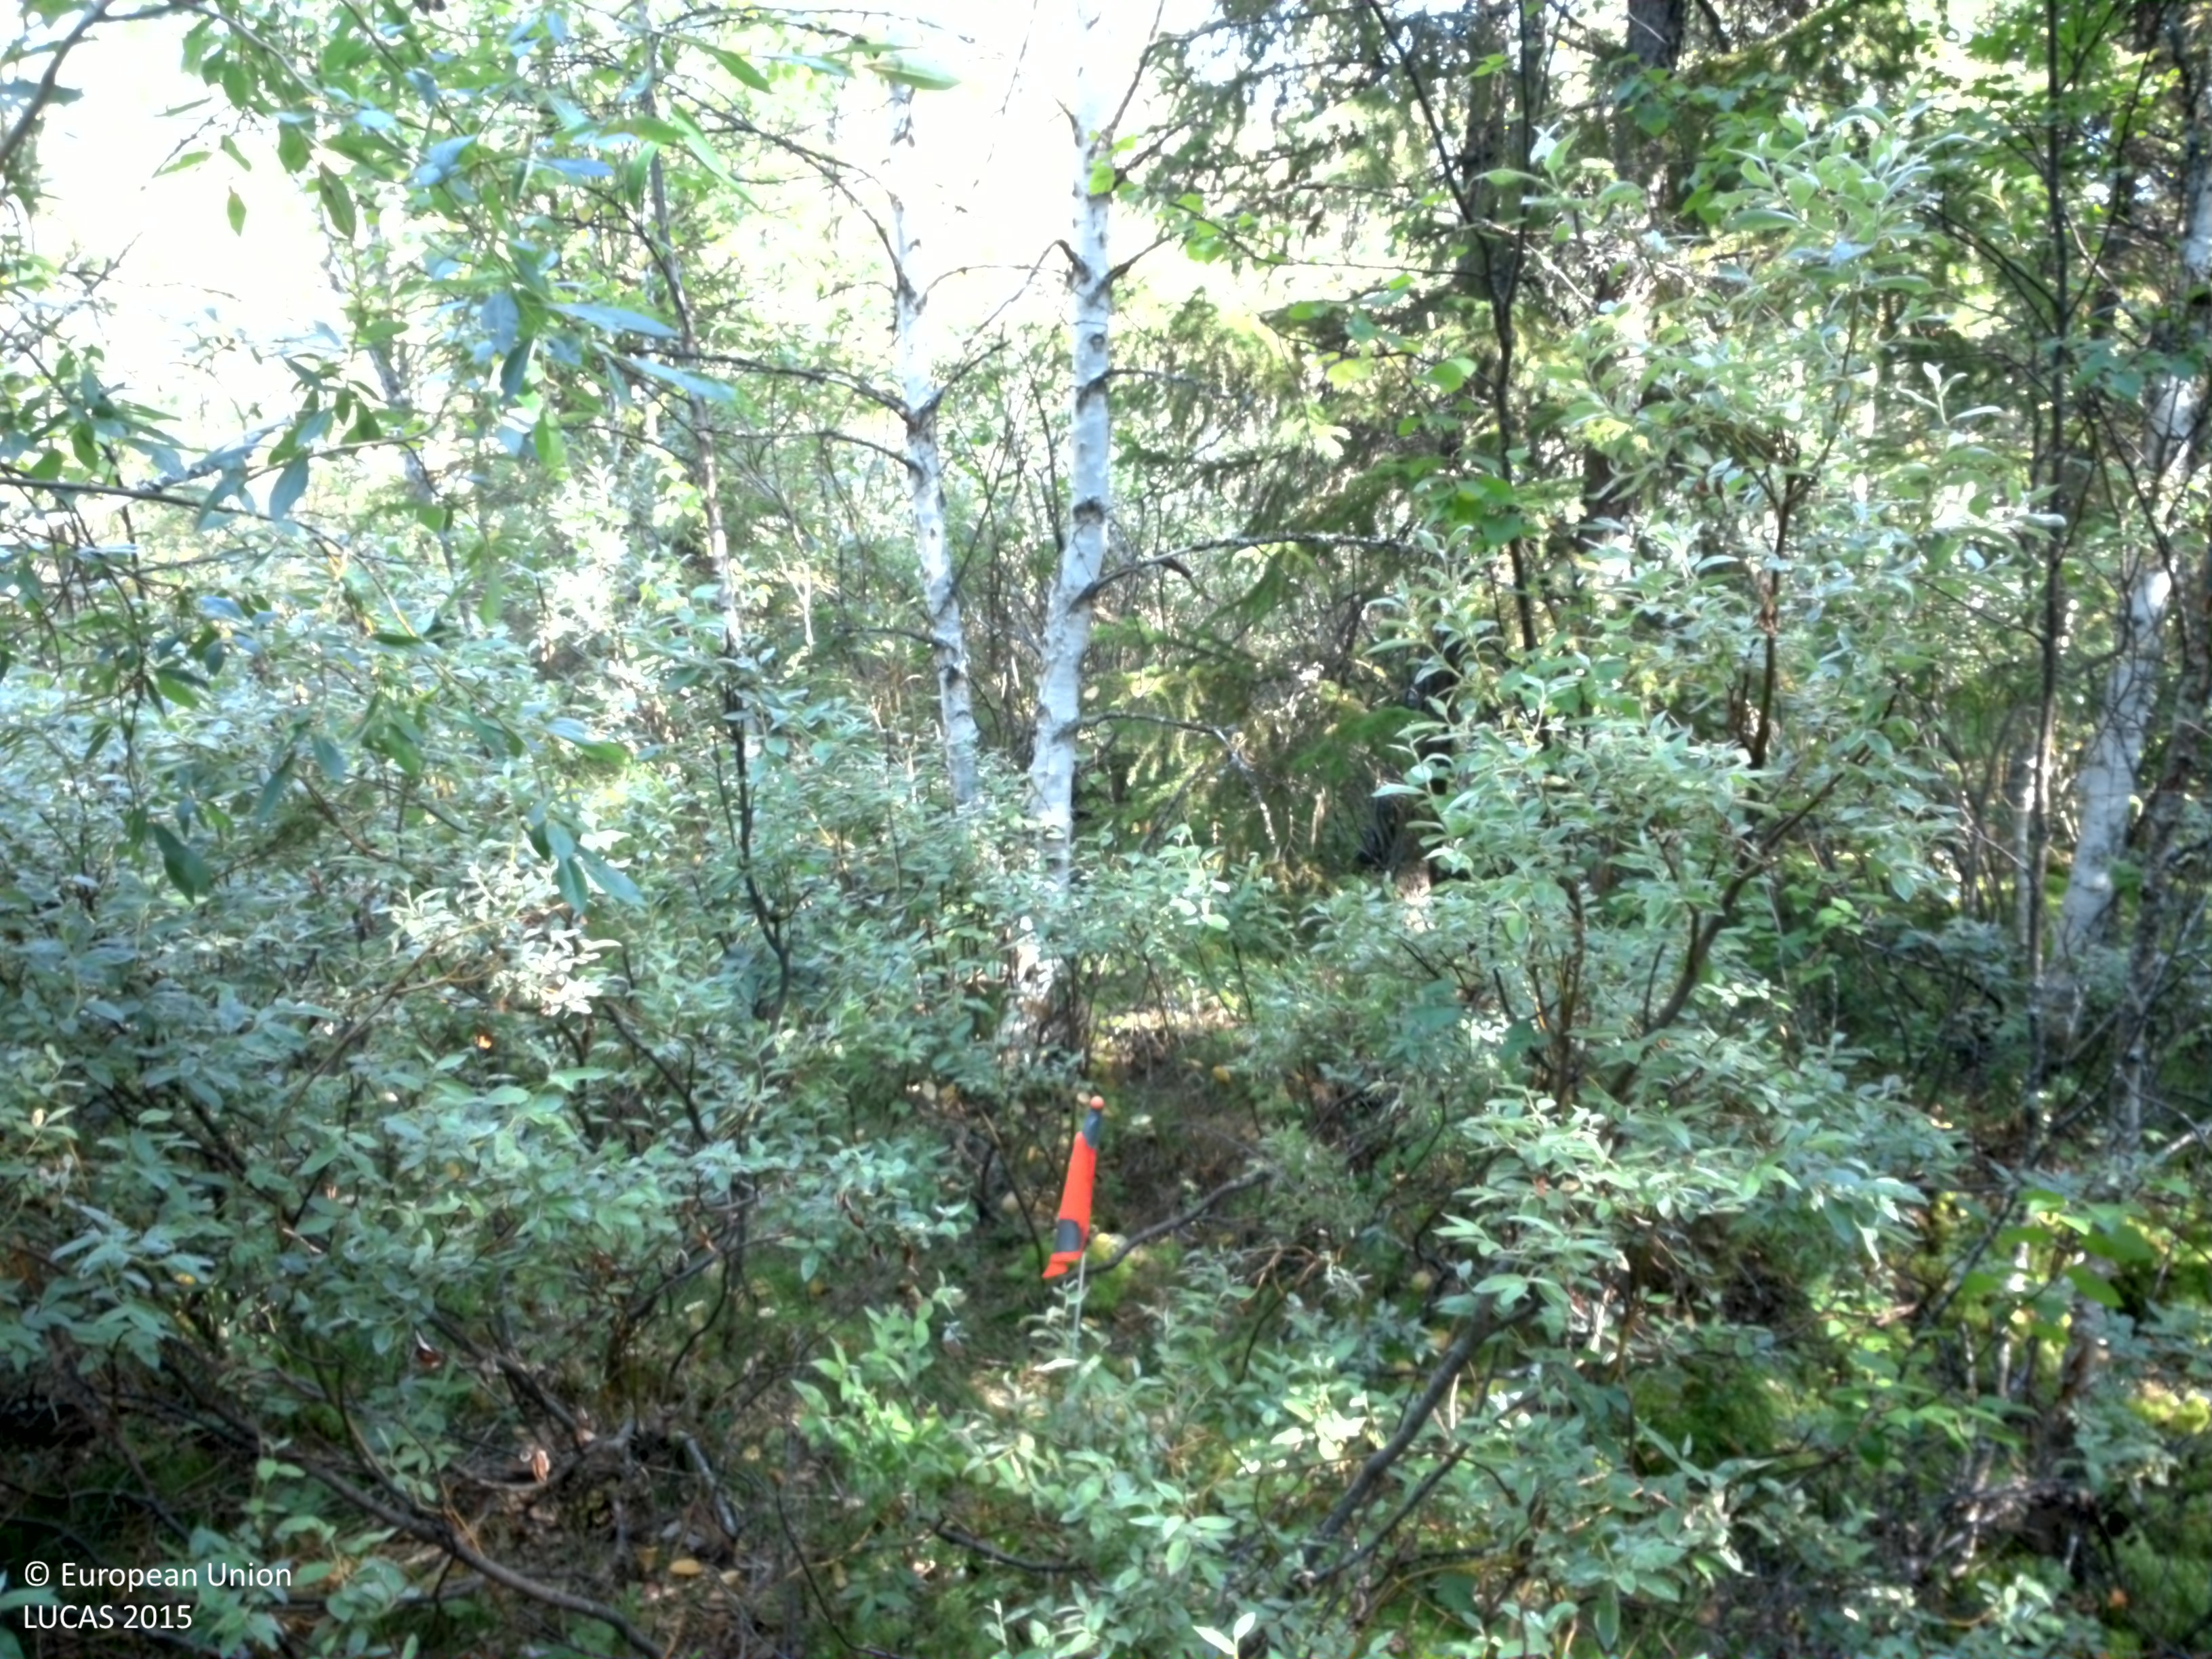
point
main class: Woodland
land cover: Broadleaved woodland
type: non-riverine alder, birch or aspen forest
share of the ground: 25 - 50 %
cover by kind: shrubs 40 %, broadleaved forest trees 35 %, coniferous forest trees 10 %, lichens and mosses 10 %, herbaceous plants 5 %
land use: Semi-natural and natural areas not in use
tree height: > 5 m
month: August
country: SE
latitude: 64.6578
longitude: 16.6463
